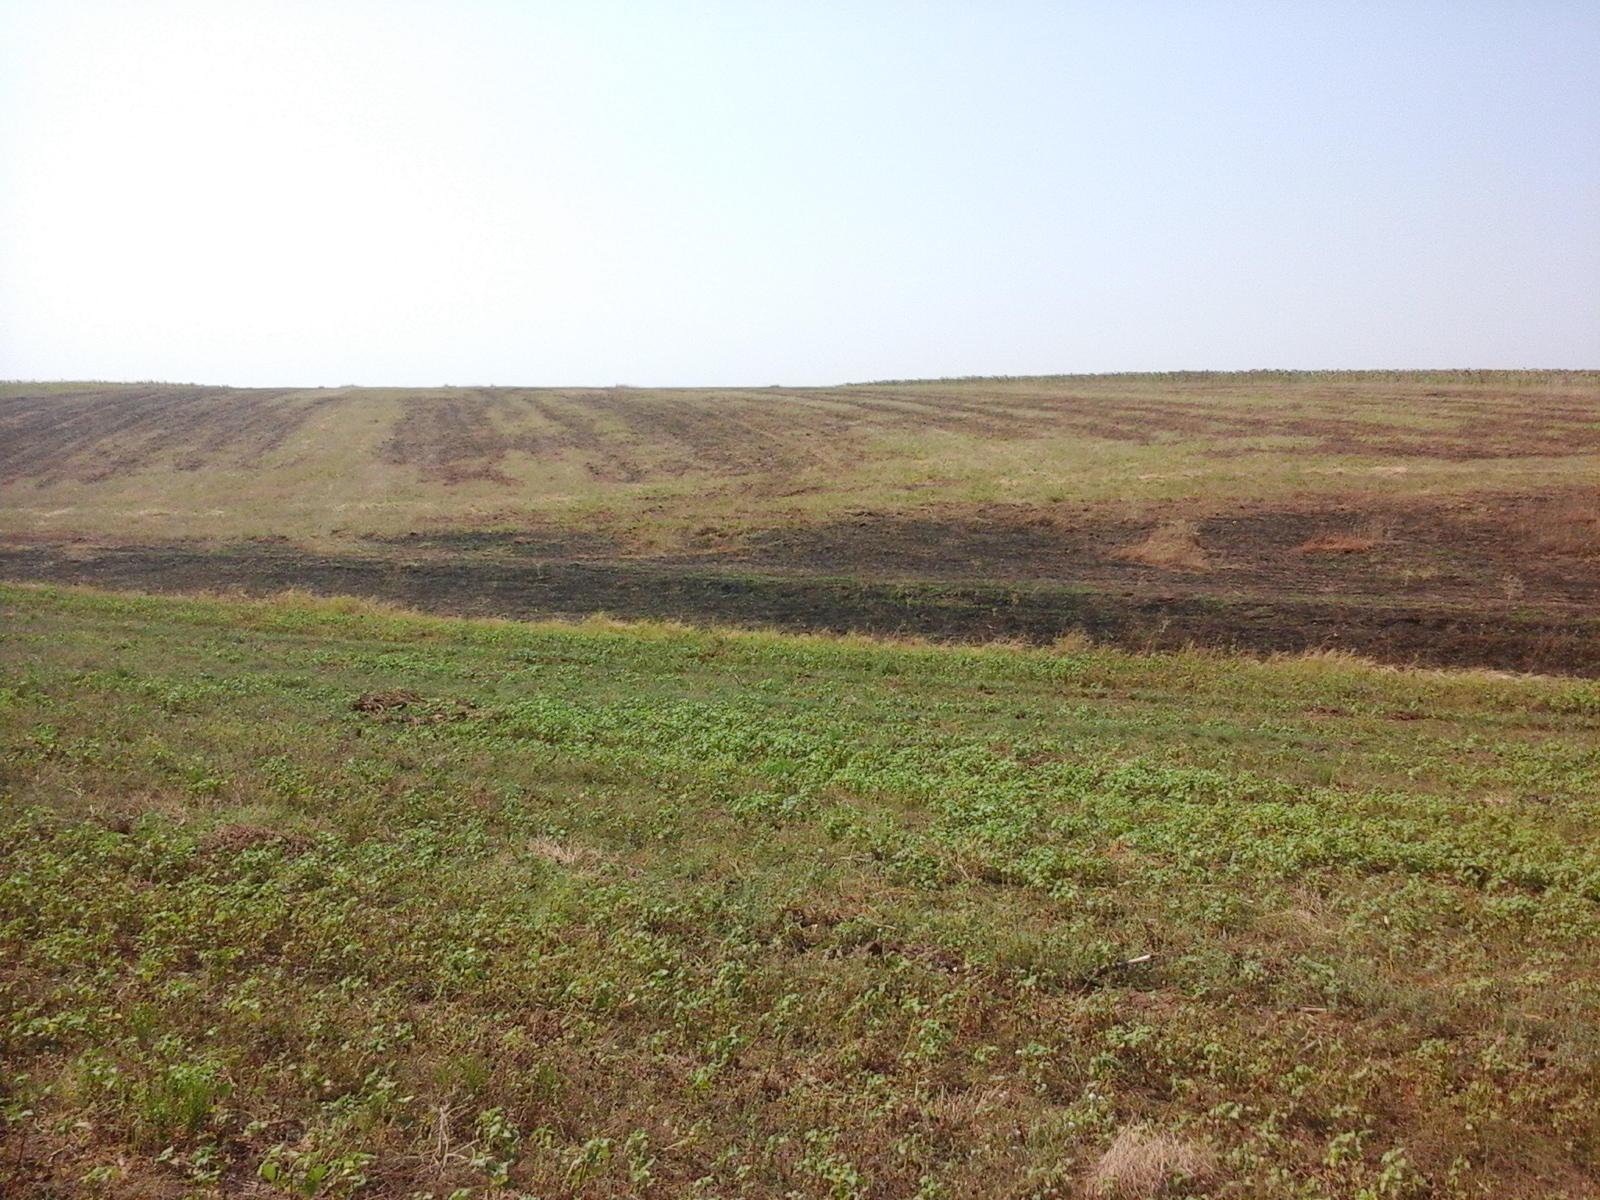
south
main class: Grassland
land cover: Spontaneously vegetated surfaces
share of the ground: > 75 %
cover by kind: herbaceous plants 100 %
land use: Fallow land
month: August
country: RO
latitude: 44.2023
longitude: 23.2994
